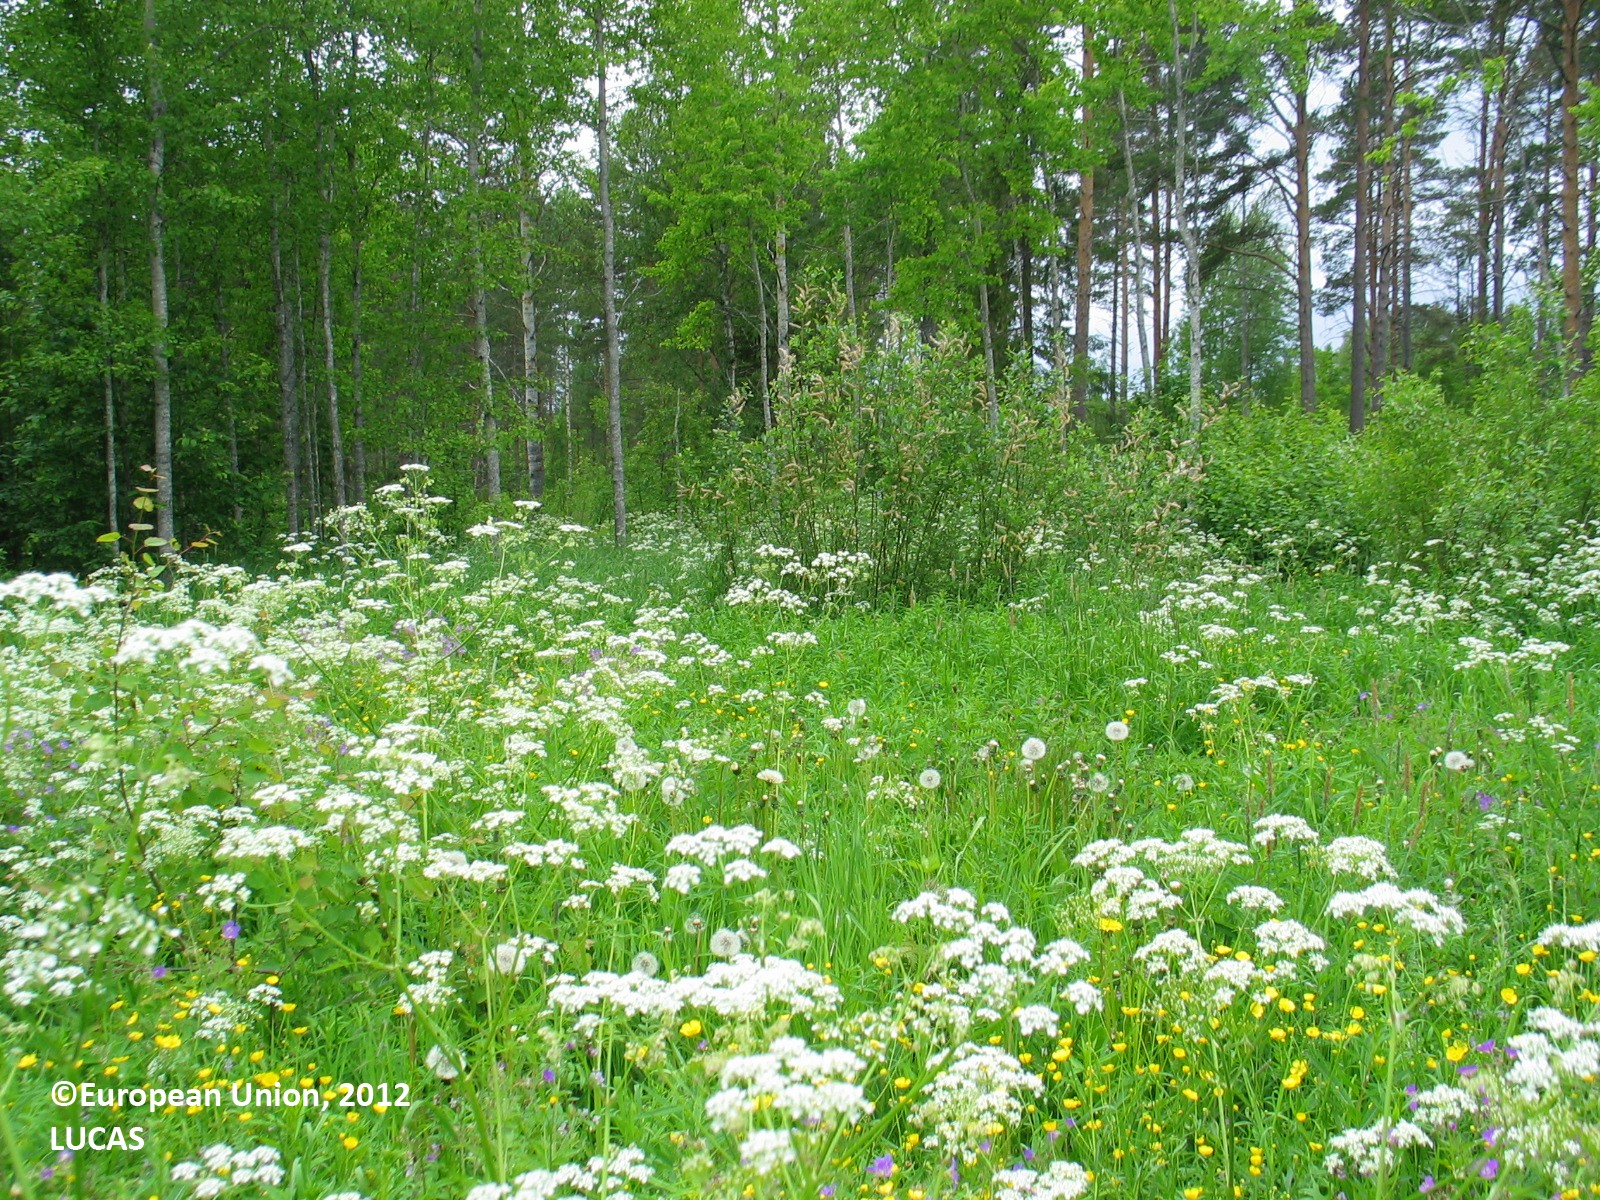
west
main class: Grassland
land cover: Grassland without tree/shrub cover
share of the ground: > 75 %
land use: Residential
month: June
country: FI
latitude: 65.1935
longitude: 25.3951
